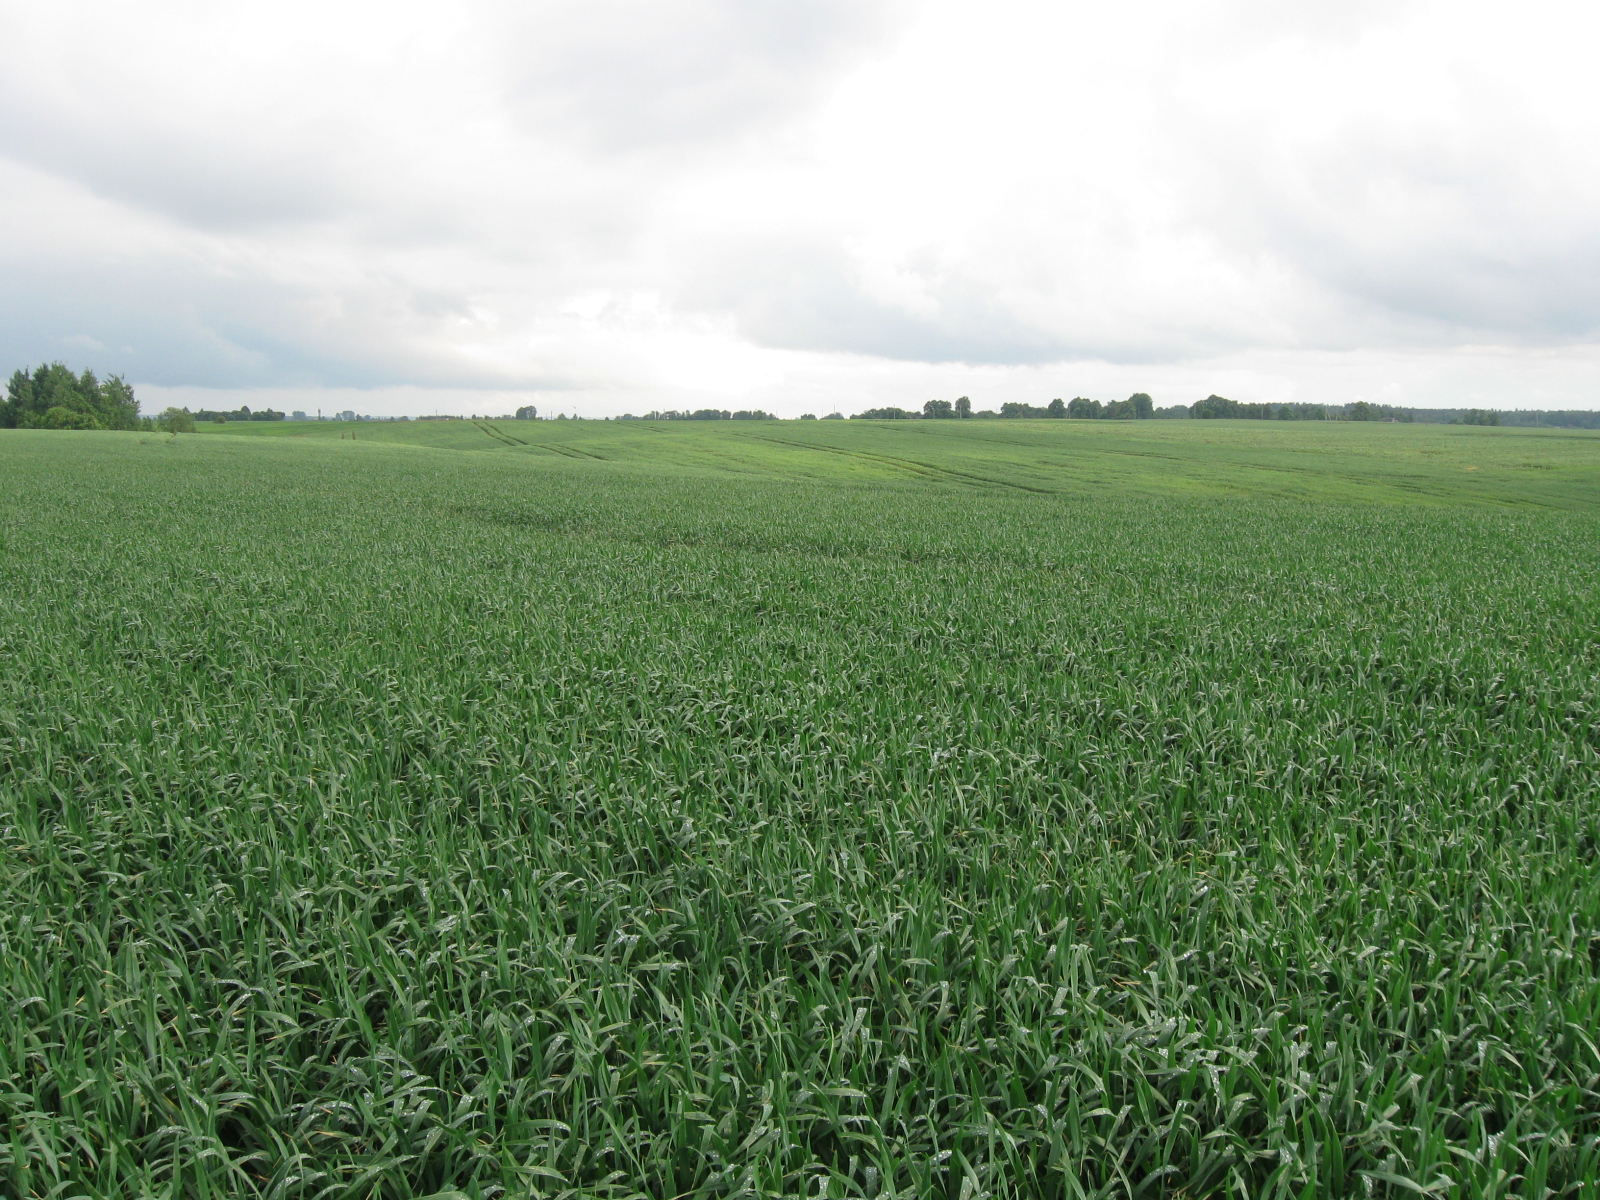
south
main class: Cropland
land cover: Common wheat
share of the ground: > 75 %
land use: Agriculture (excluding fallow land and kitchen gardens)
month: June
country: LT
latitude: 54.9608
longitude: 24.4535
